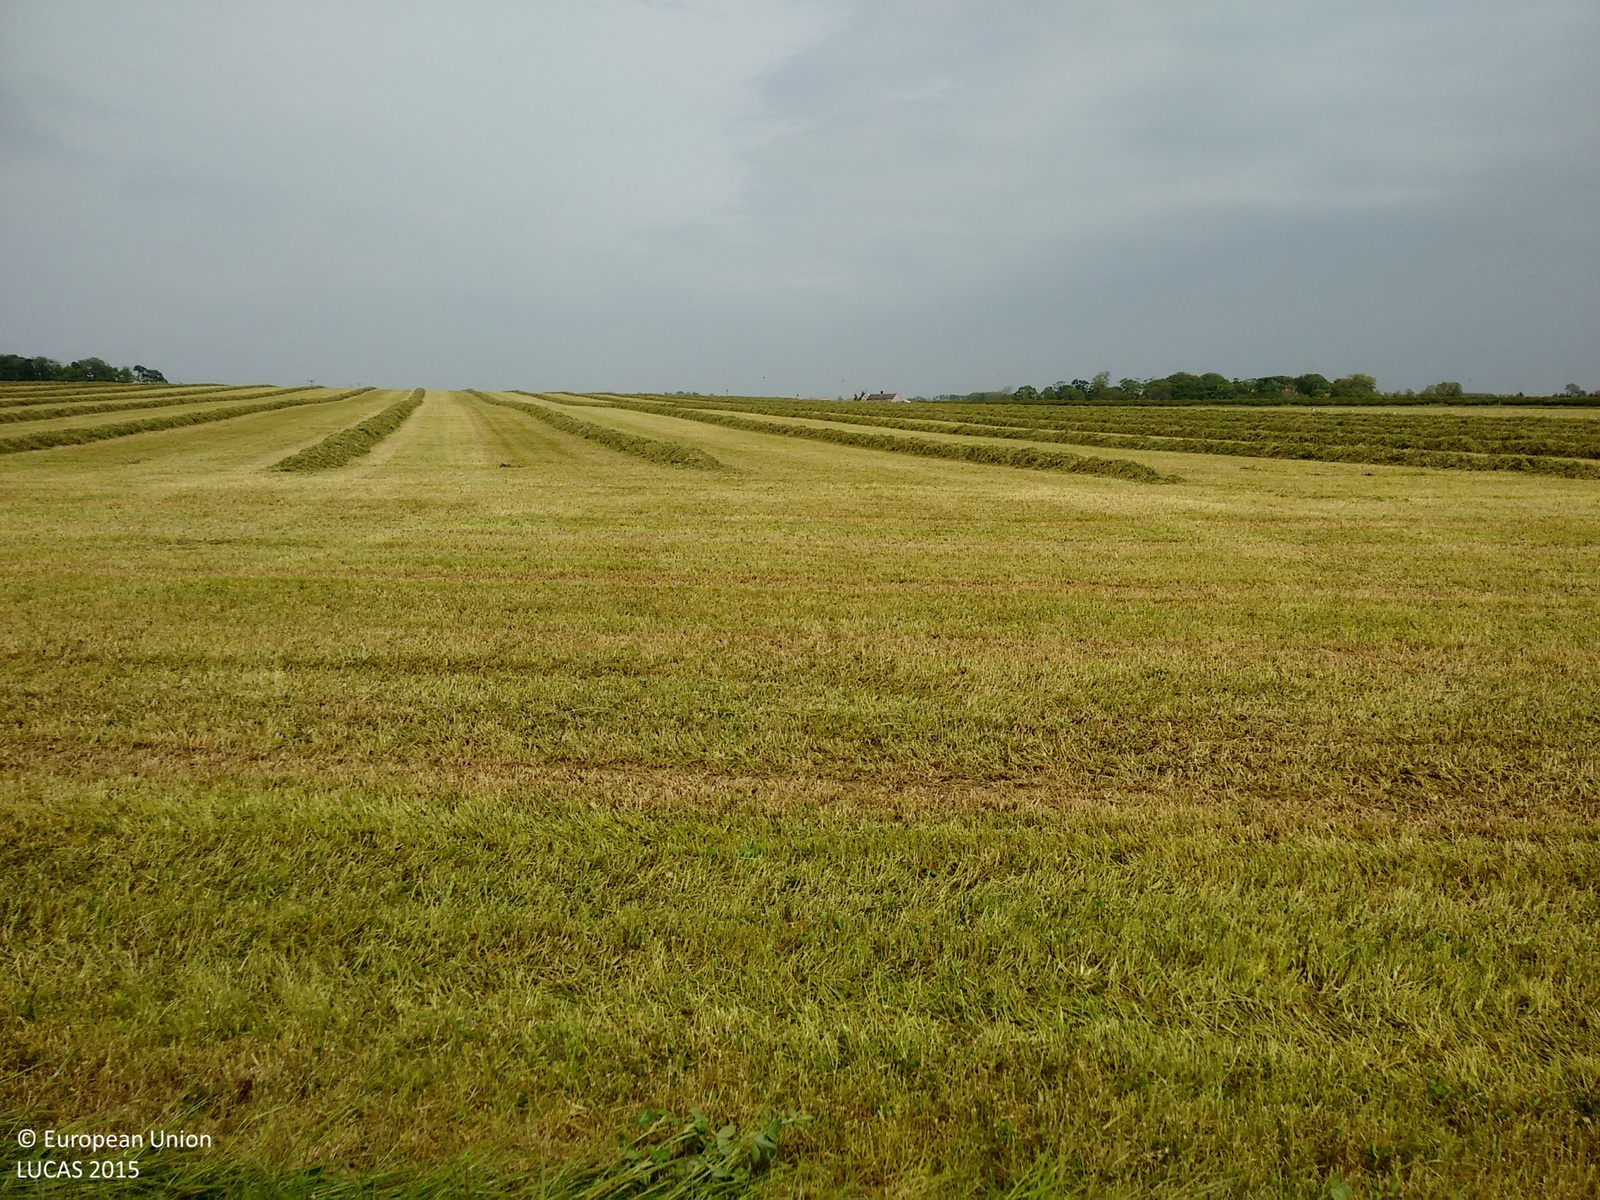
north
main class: Grassland
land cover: Grassland without tree/shrub cover
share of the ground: > 75 %
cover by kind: herbaceous plants 100 %
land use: Agriculture (excluding fallow land and kitchen gardens)
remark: Harvested field
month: June
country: GB
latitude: 55.5268
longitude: -1.6598
